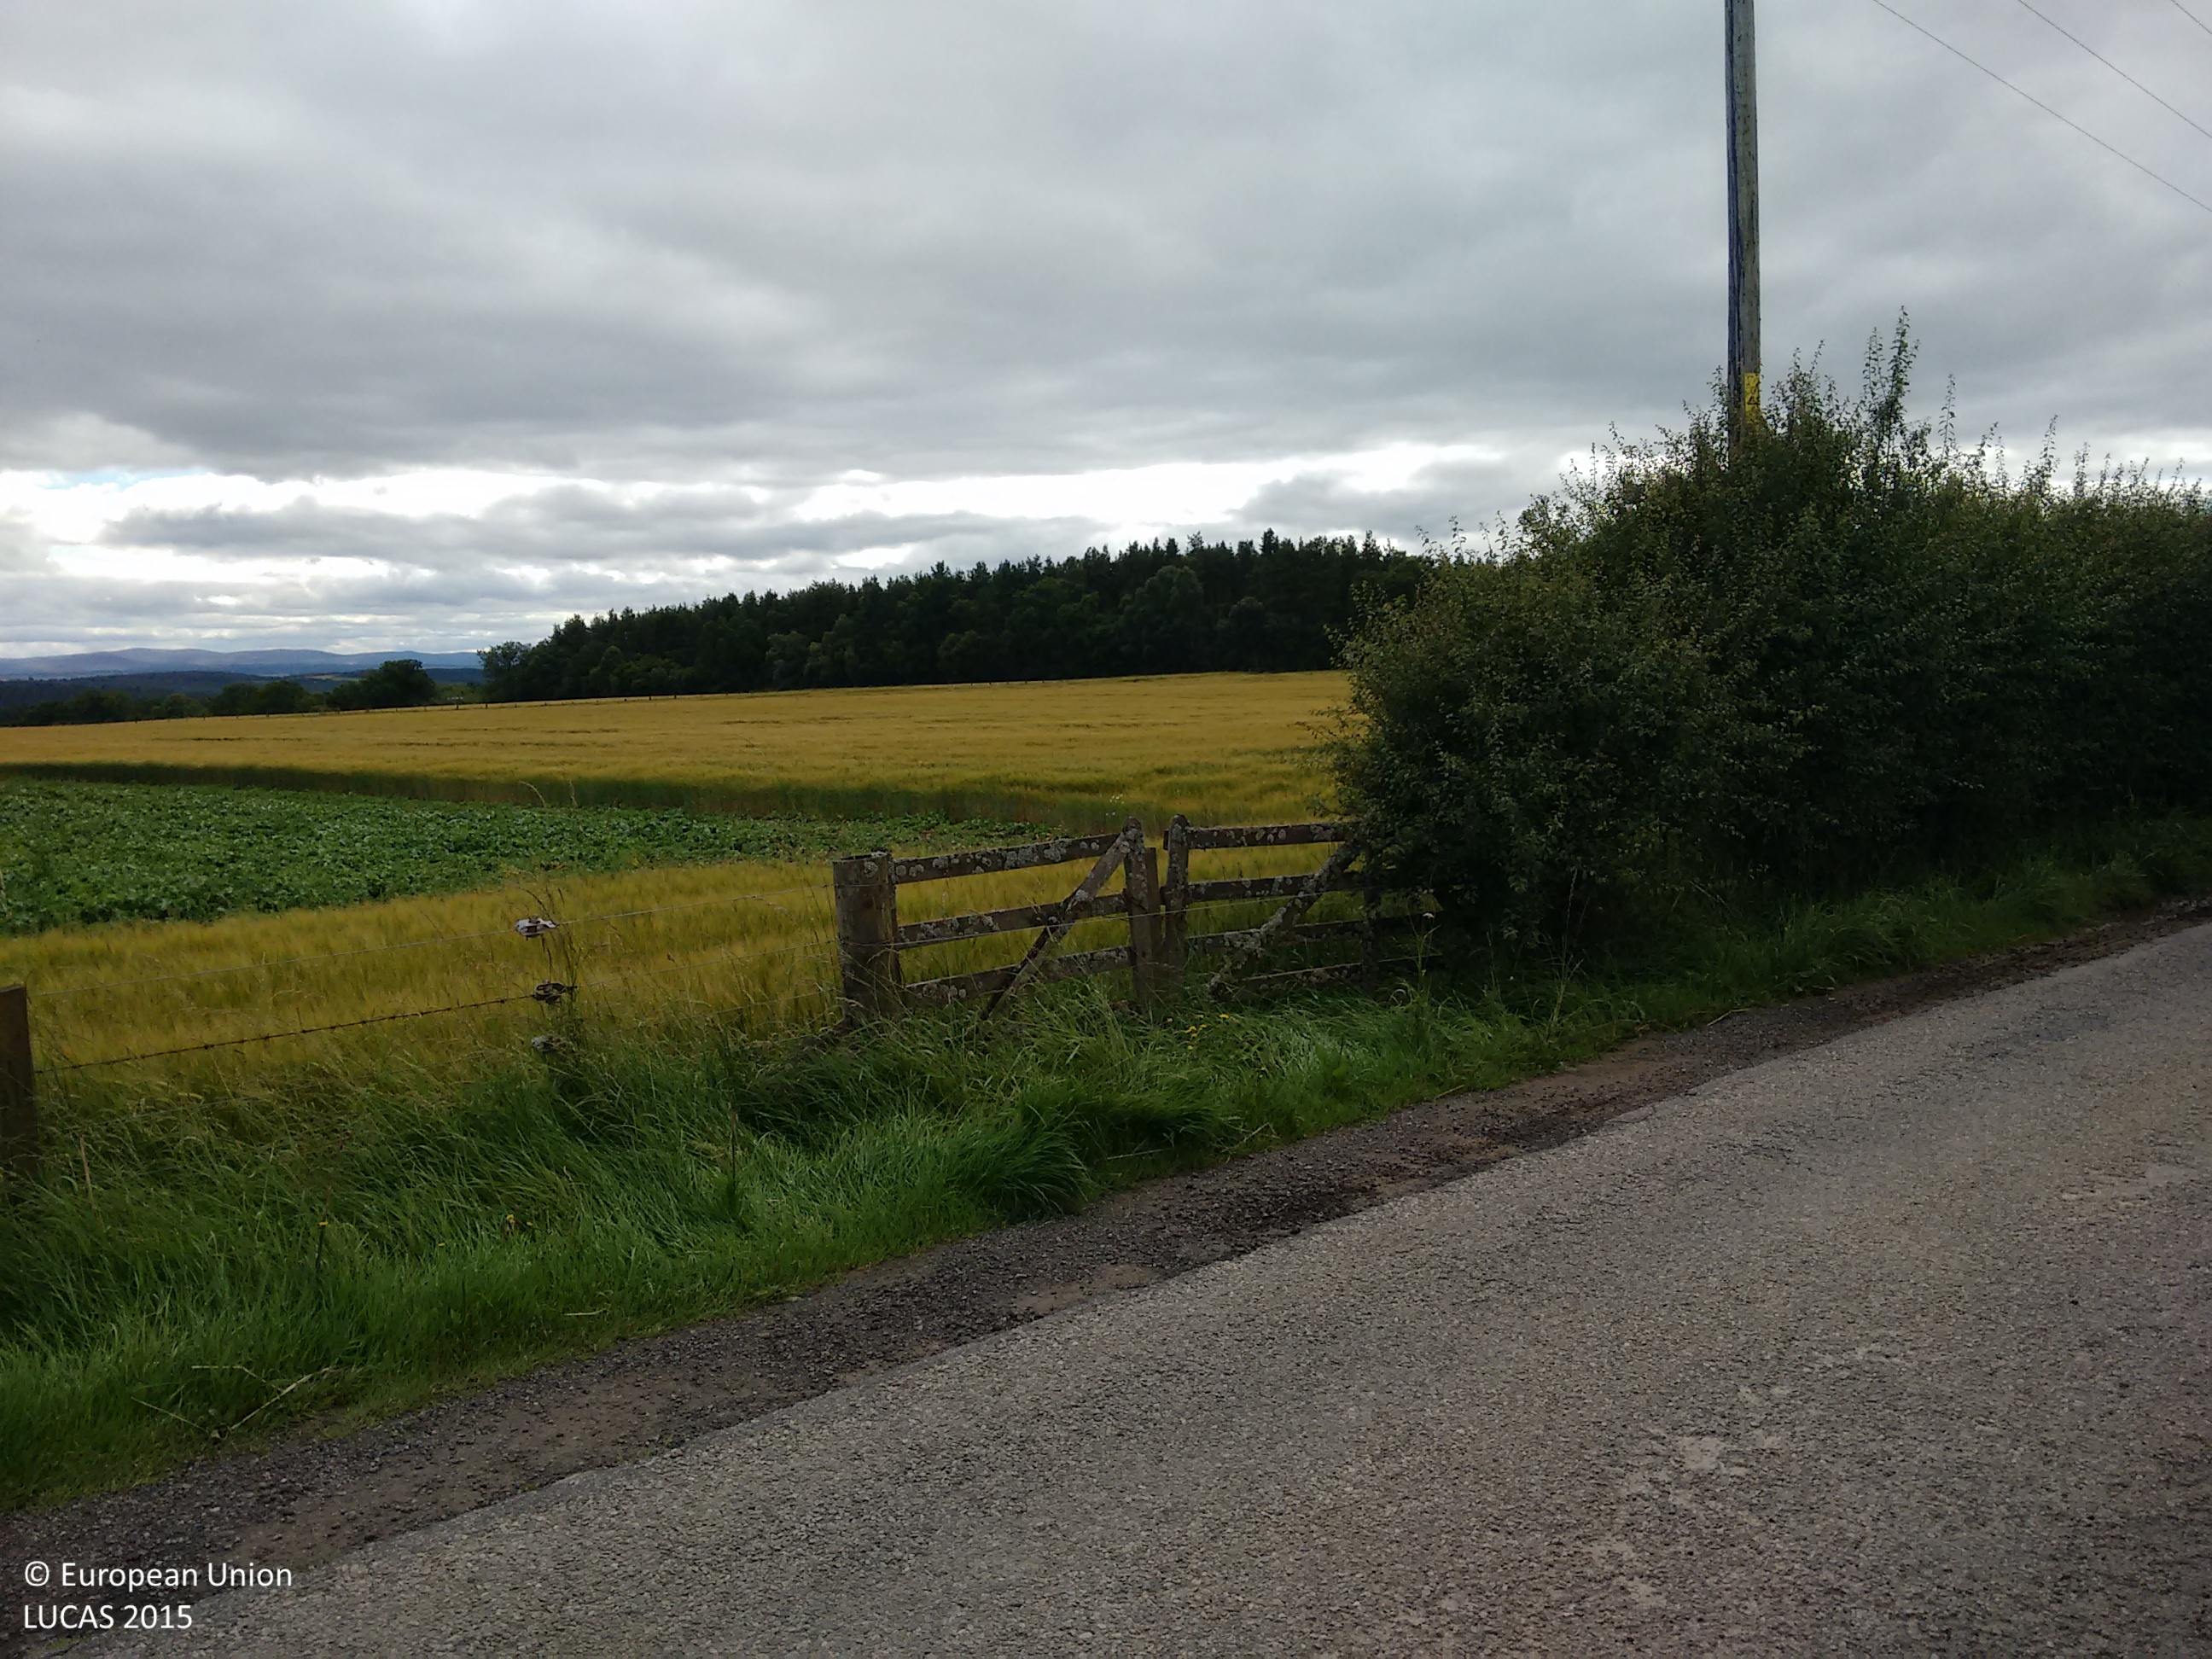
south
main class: Cropland
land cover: Potatoes
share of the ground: > 75 %
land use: Agriculture (excluding fallow land and kitchen gardens)
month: August
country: GB
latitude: 57.5827
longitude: -4.2513
